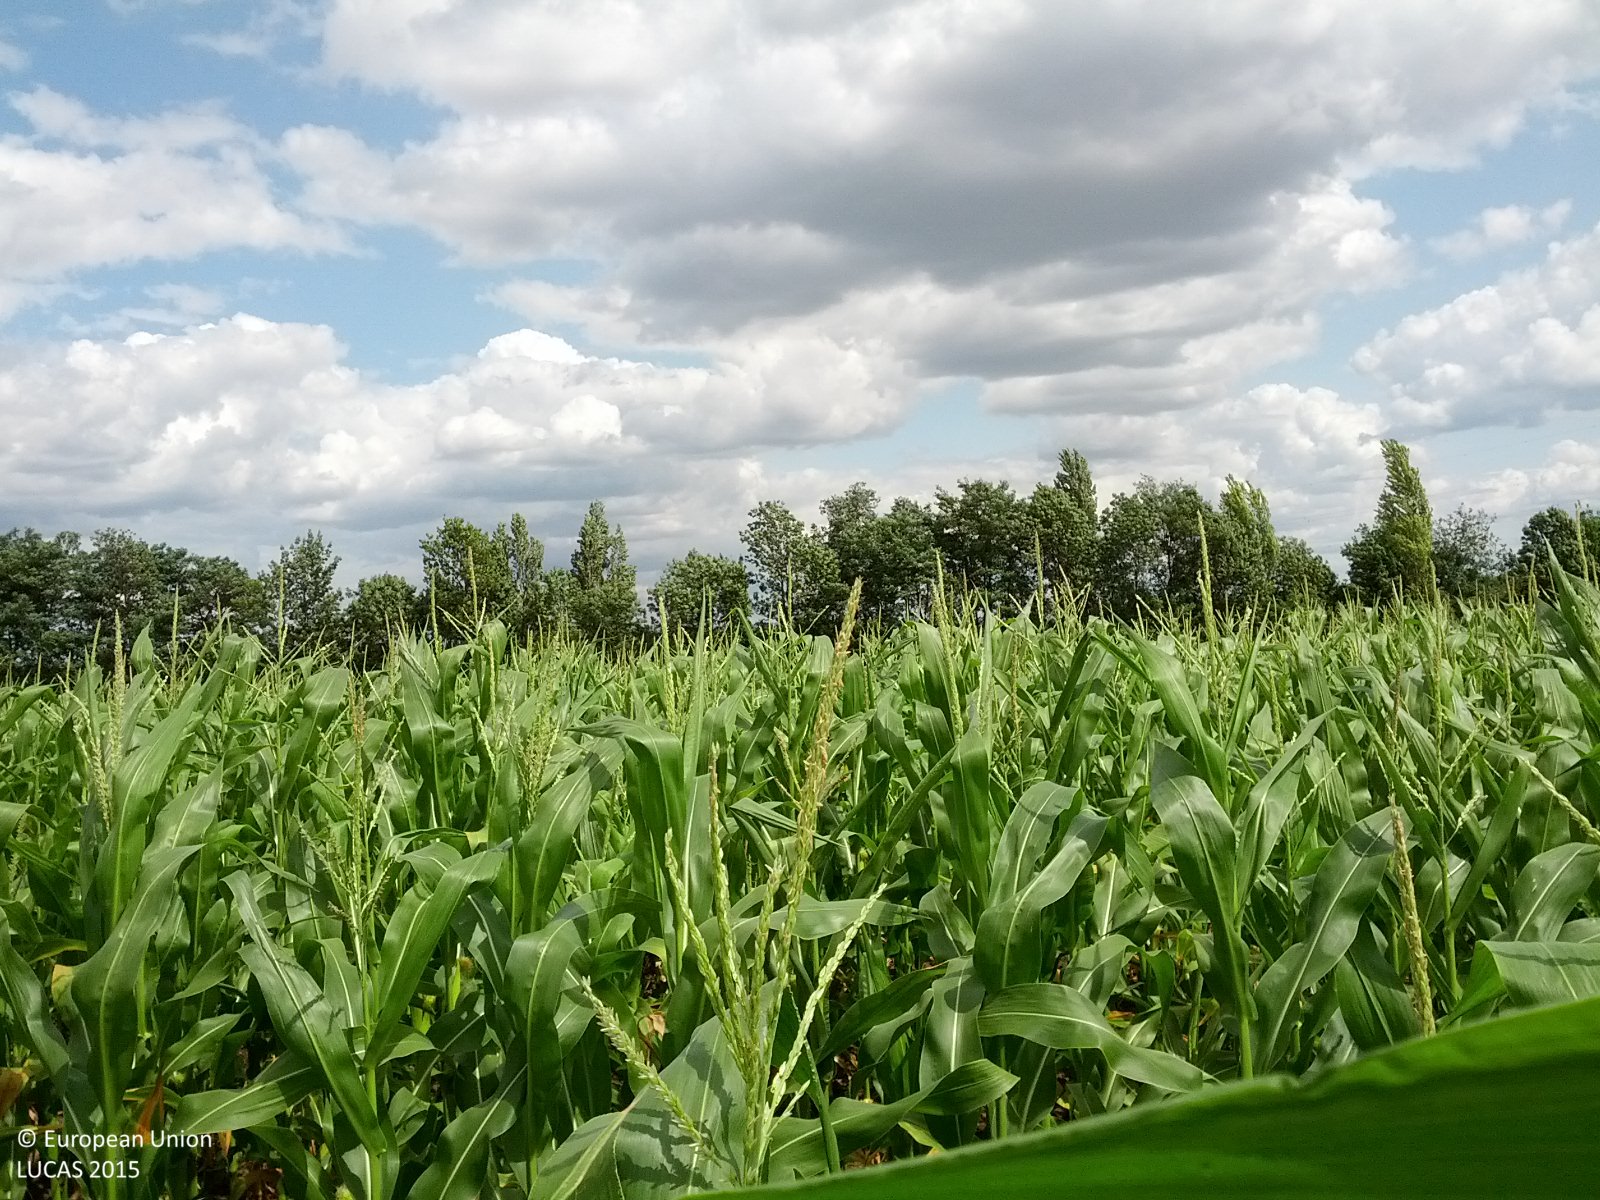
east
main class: Cropland
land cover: Maize
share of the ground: > 75 %
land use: Agriculture (excluding fallow land and kitchen gardens)
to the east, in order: Maize; Common wheat; Broadleaved woodland; Grass margins; Tracks; Grass margins; Common wheat; Sugar beet
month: July
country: AT
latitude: 48.7112
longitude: 16.2979
